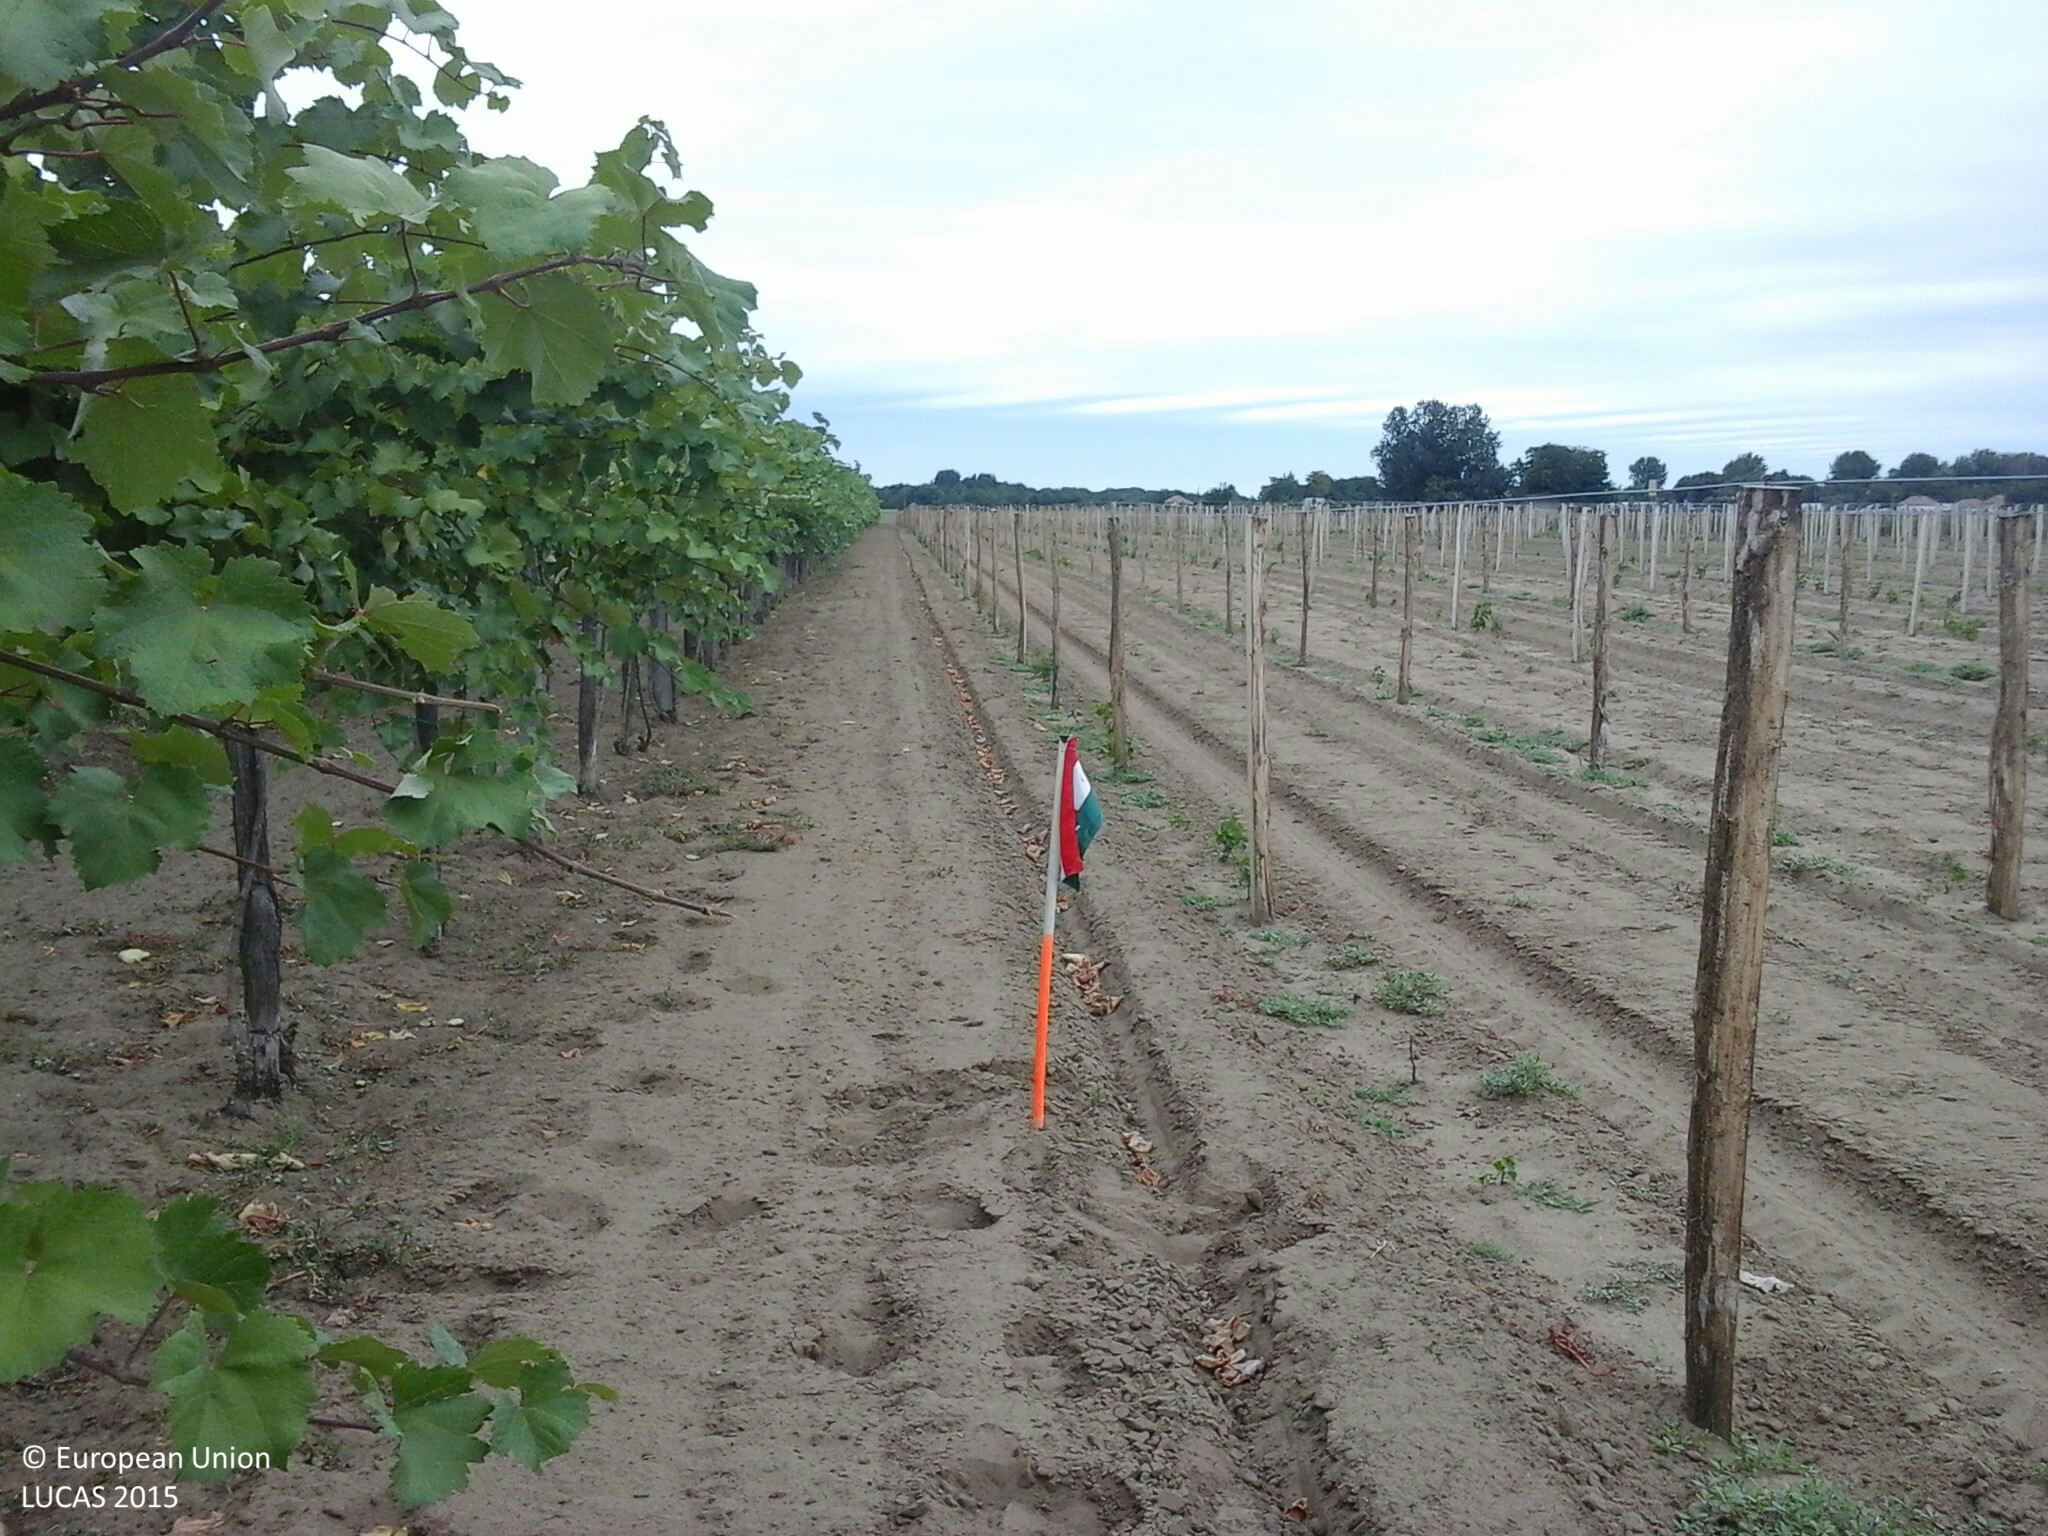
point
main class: Cropland
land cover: Vineyards
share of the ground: 25 - 50 %
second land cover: Other bare soil
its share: > 75 %
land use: Agriculture (excluding fallow land and kitchen gardens)
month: July
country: HU
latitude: 46.8484
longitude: 20.1355
